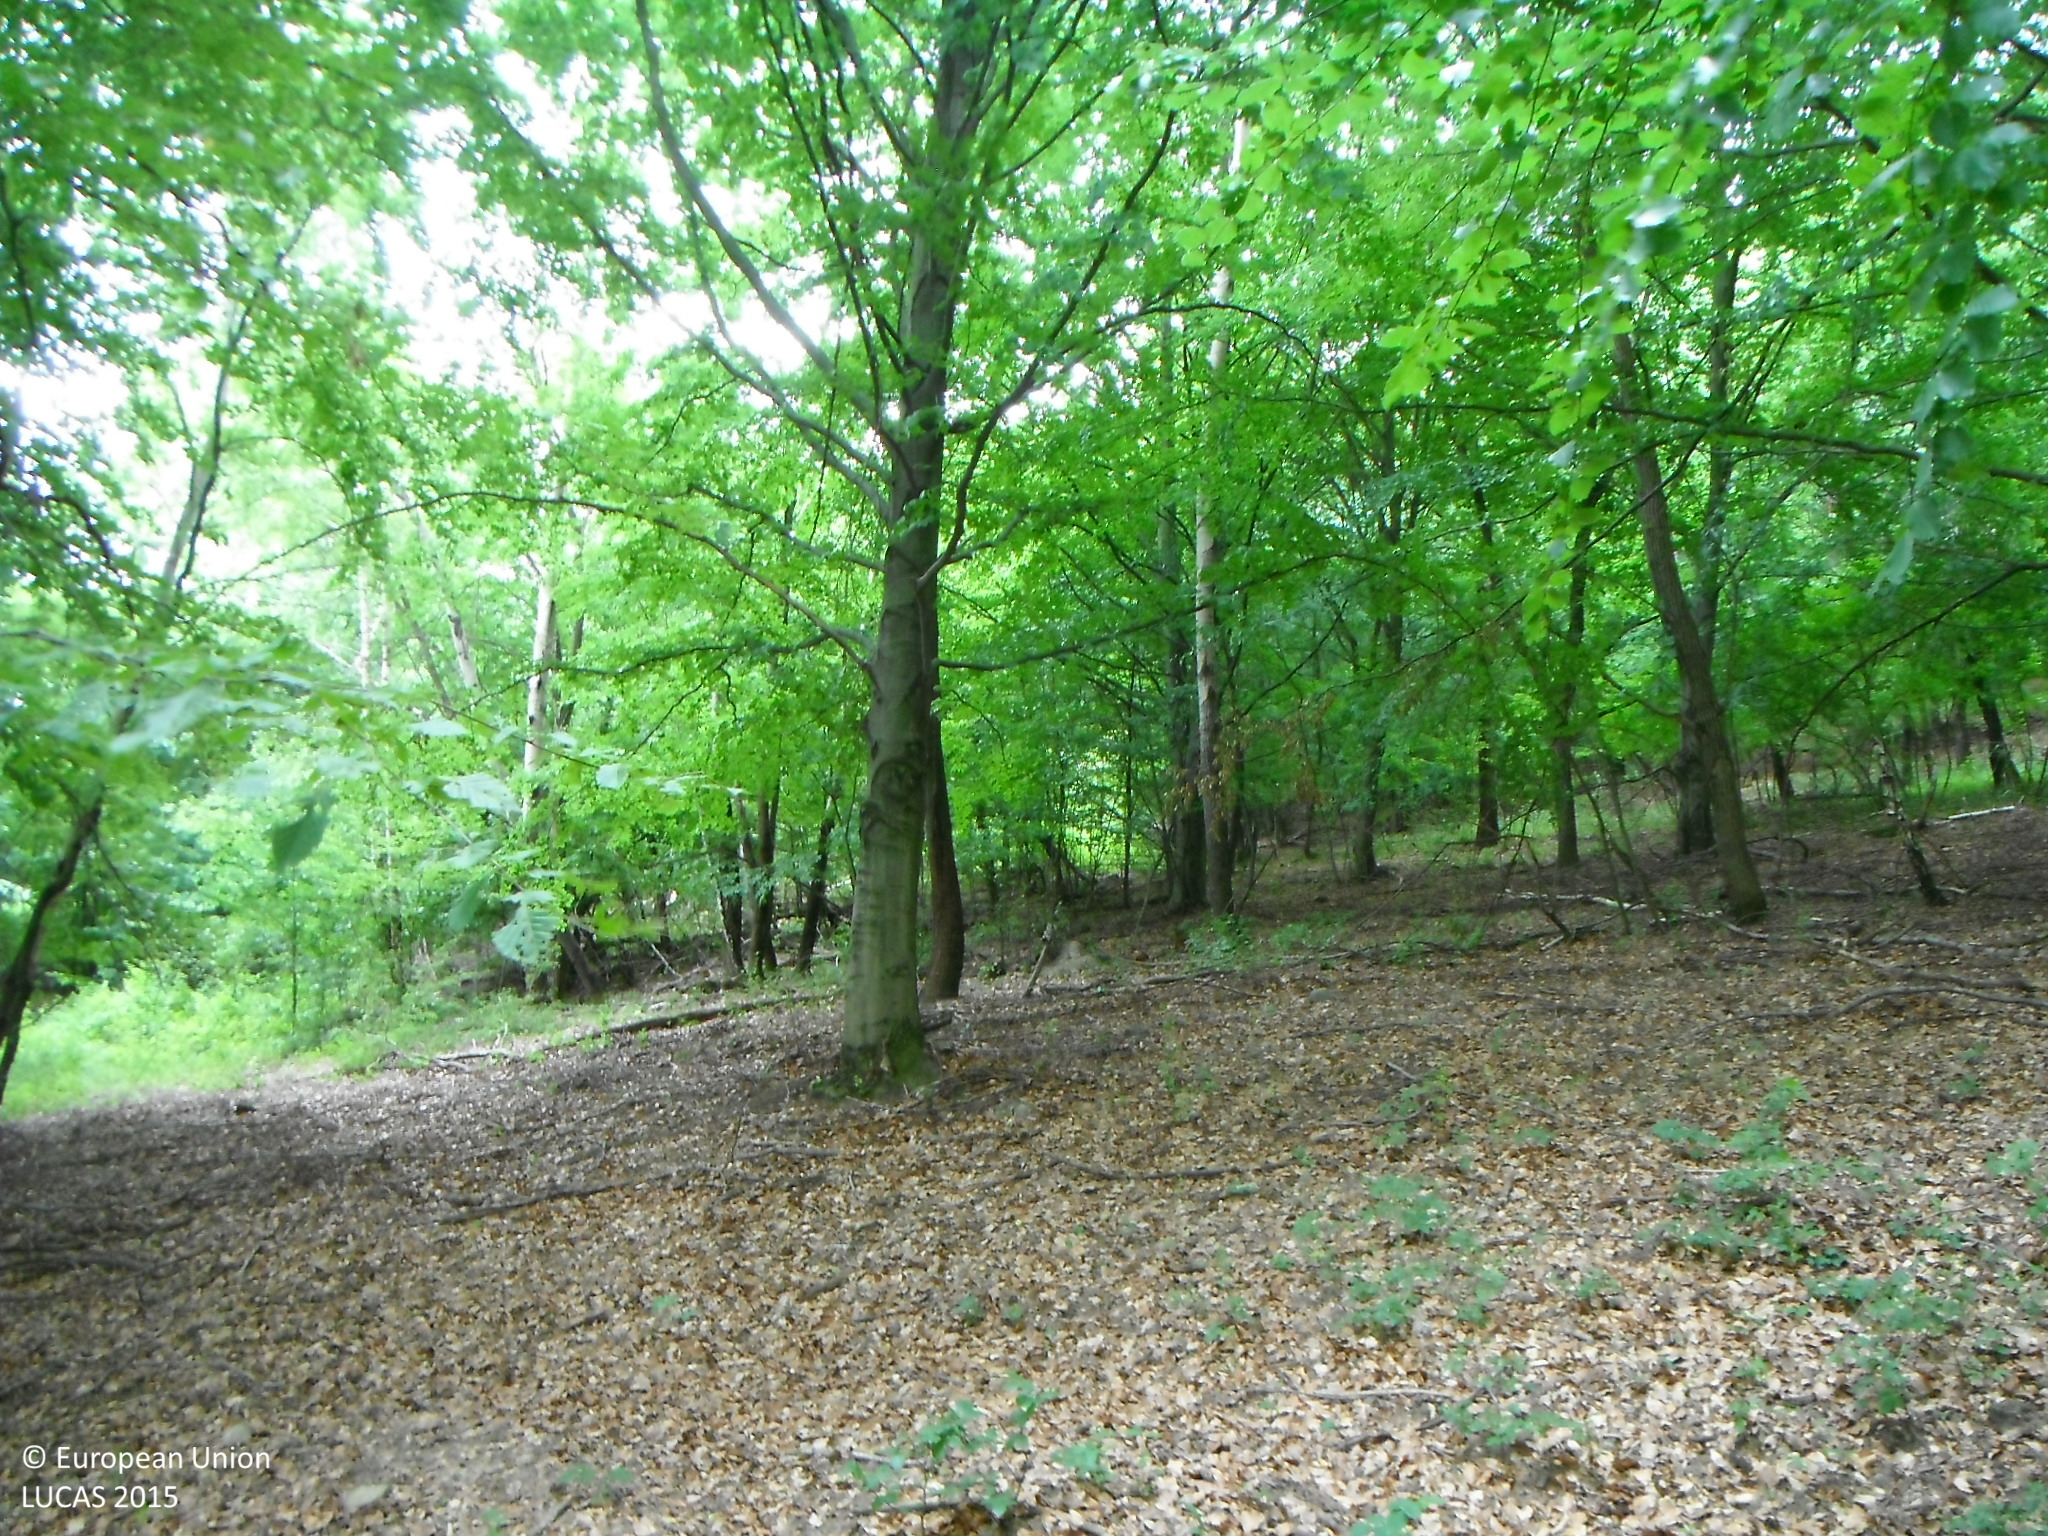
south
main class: Woodland
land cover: Broadleaved woodland
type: mesophytic deciduous forest
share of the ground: > 75 %
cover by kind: broadleaved forest trees 100 %
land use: Forestry
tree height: > 5 m
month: July
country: SK
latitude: 48.3307
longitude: 18.9358
